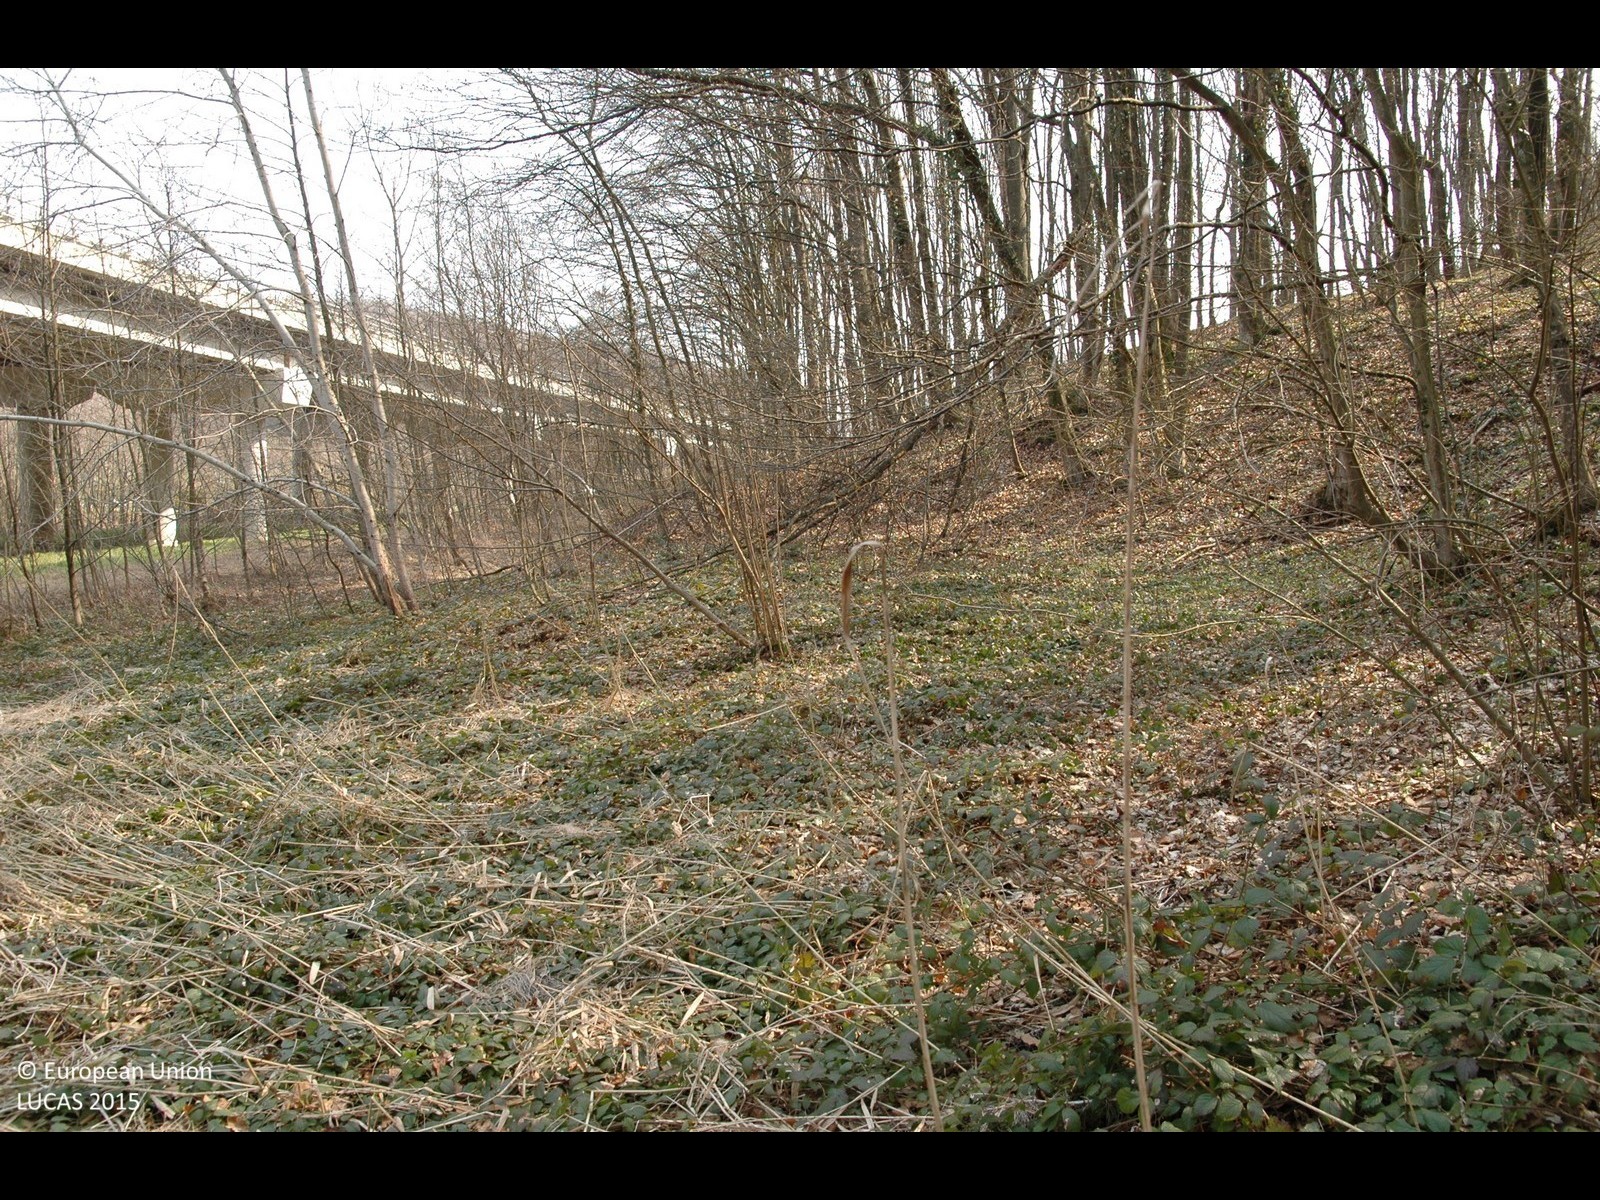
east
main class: Woodland
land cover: Broadleaved woodland
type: mesophytic deciduous forest
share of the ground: > 75 %
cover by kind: broadleaved forest trees 90 %
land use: Forestry
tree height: > 5 m
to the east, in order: Broadleaved woodland; Paved roads, cycling and walking lanes; Grass margins; Artificial constructions; Paved roads, cycling and walking lanes
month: March
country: HR
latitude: 46.1277
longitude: 16.3284
